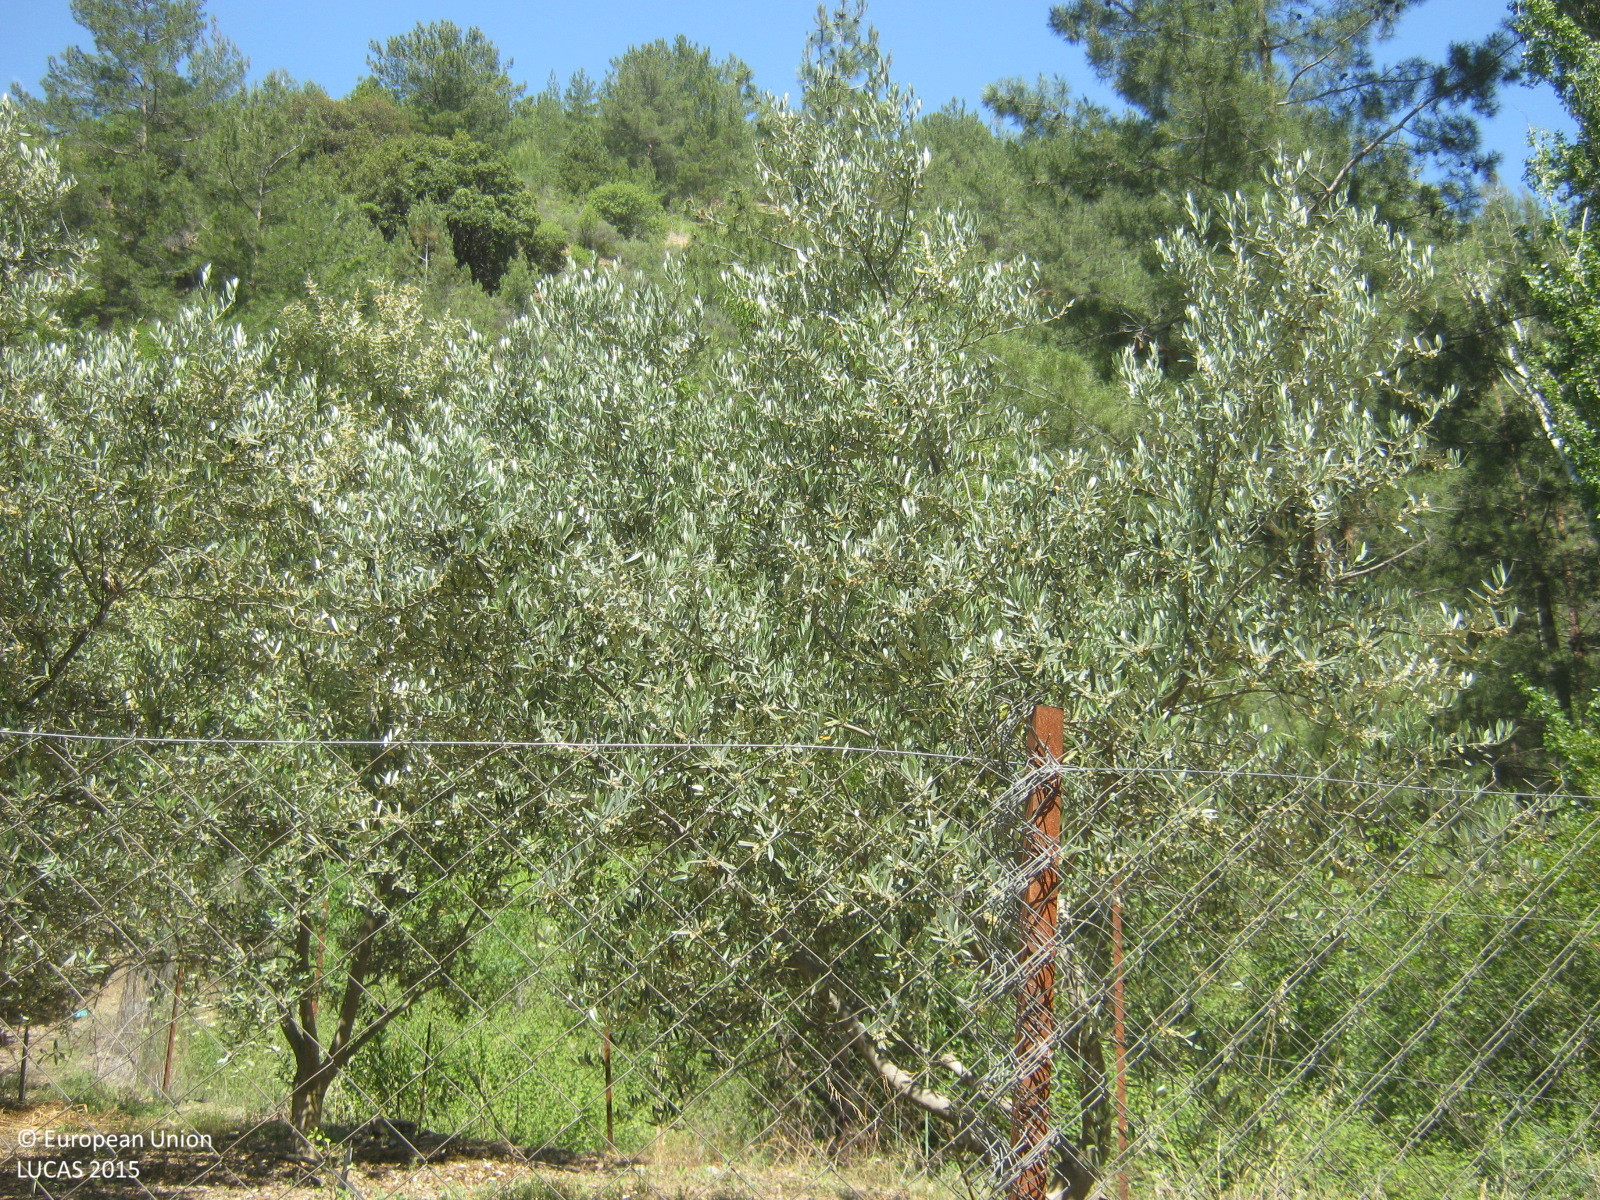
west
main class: Cropland
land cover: Olive groves
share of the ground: 50 - 75 %
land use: Agriculture (excluding fallow land and kitchen gardens)
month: June
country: CY
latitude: 34.9919
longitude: 32.8117
